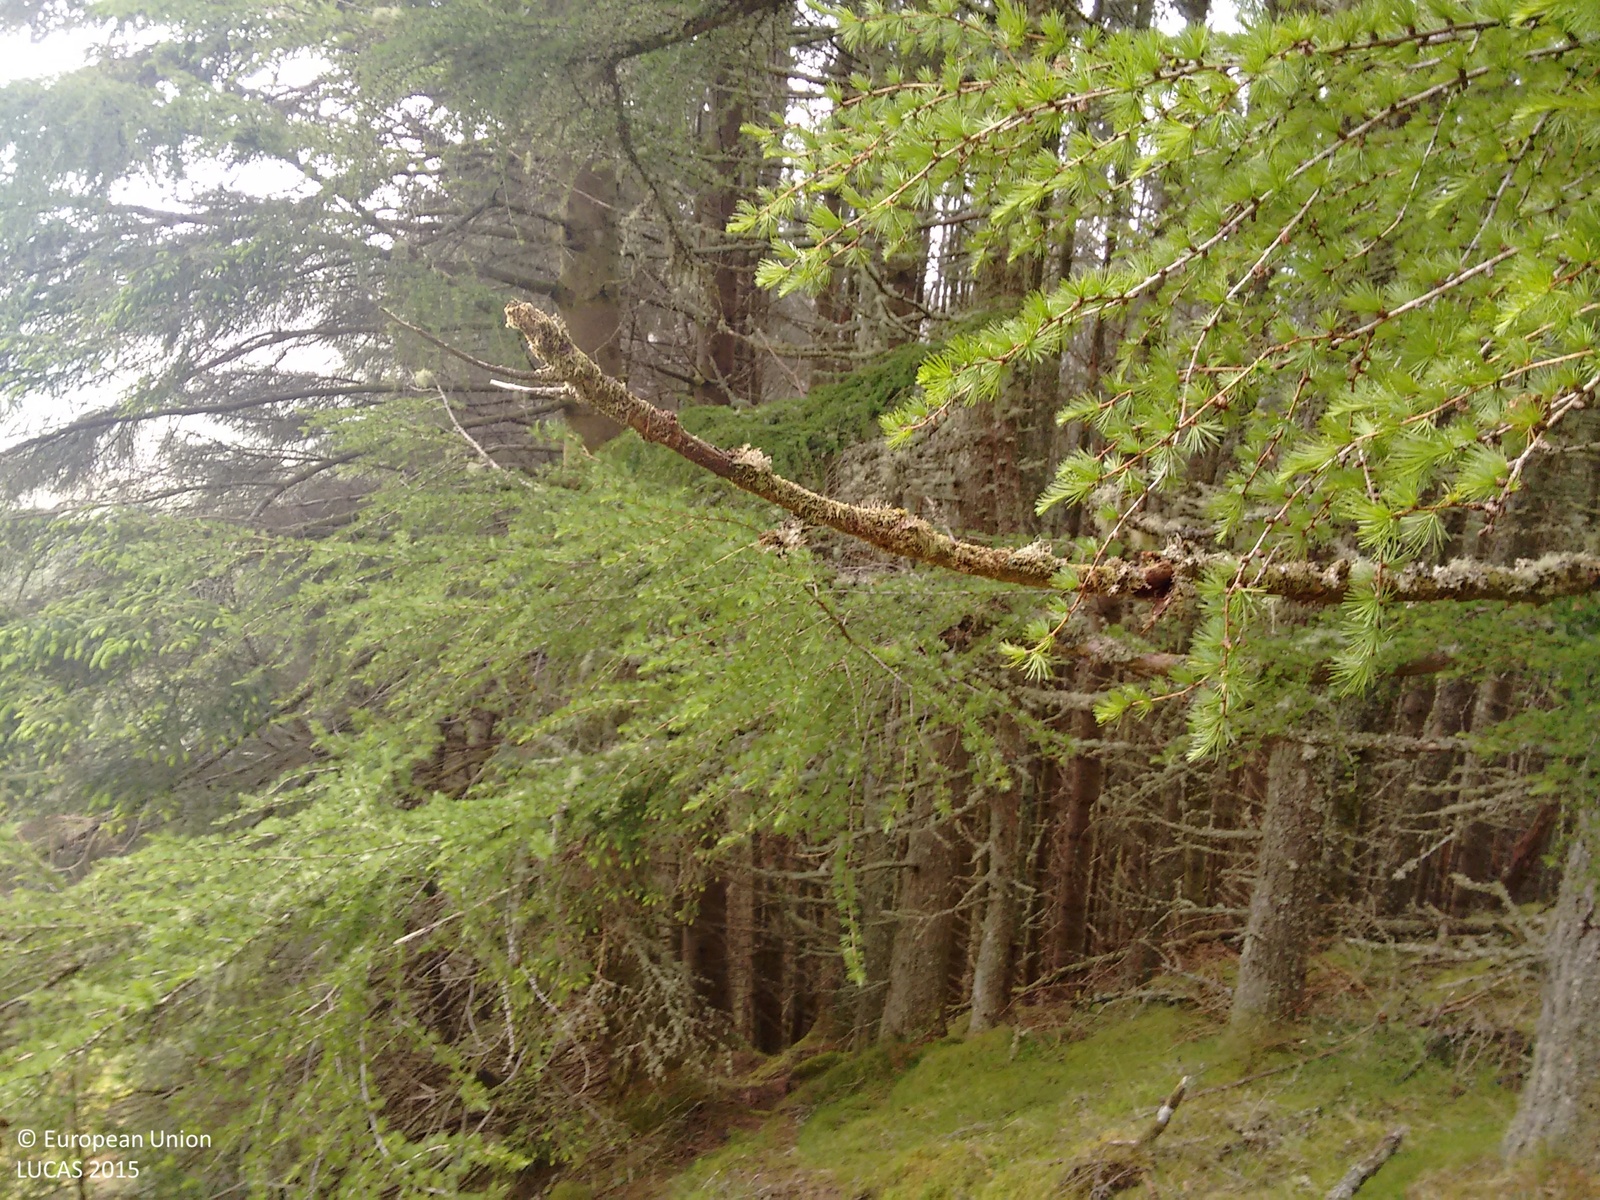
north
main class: Grassland
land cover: Grassland with sparse tree/shrub cover
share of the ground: > 75 %
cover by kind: herbaceous plants 95 %, broadleaved forest trees 5 %
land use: Forestry
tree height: > 5 m
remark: Fire break
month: June
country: GB
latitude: 56.2621
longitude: -5.3744
